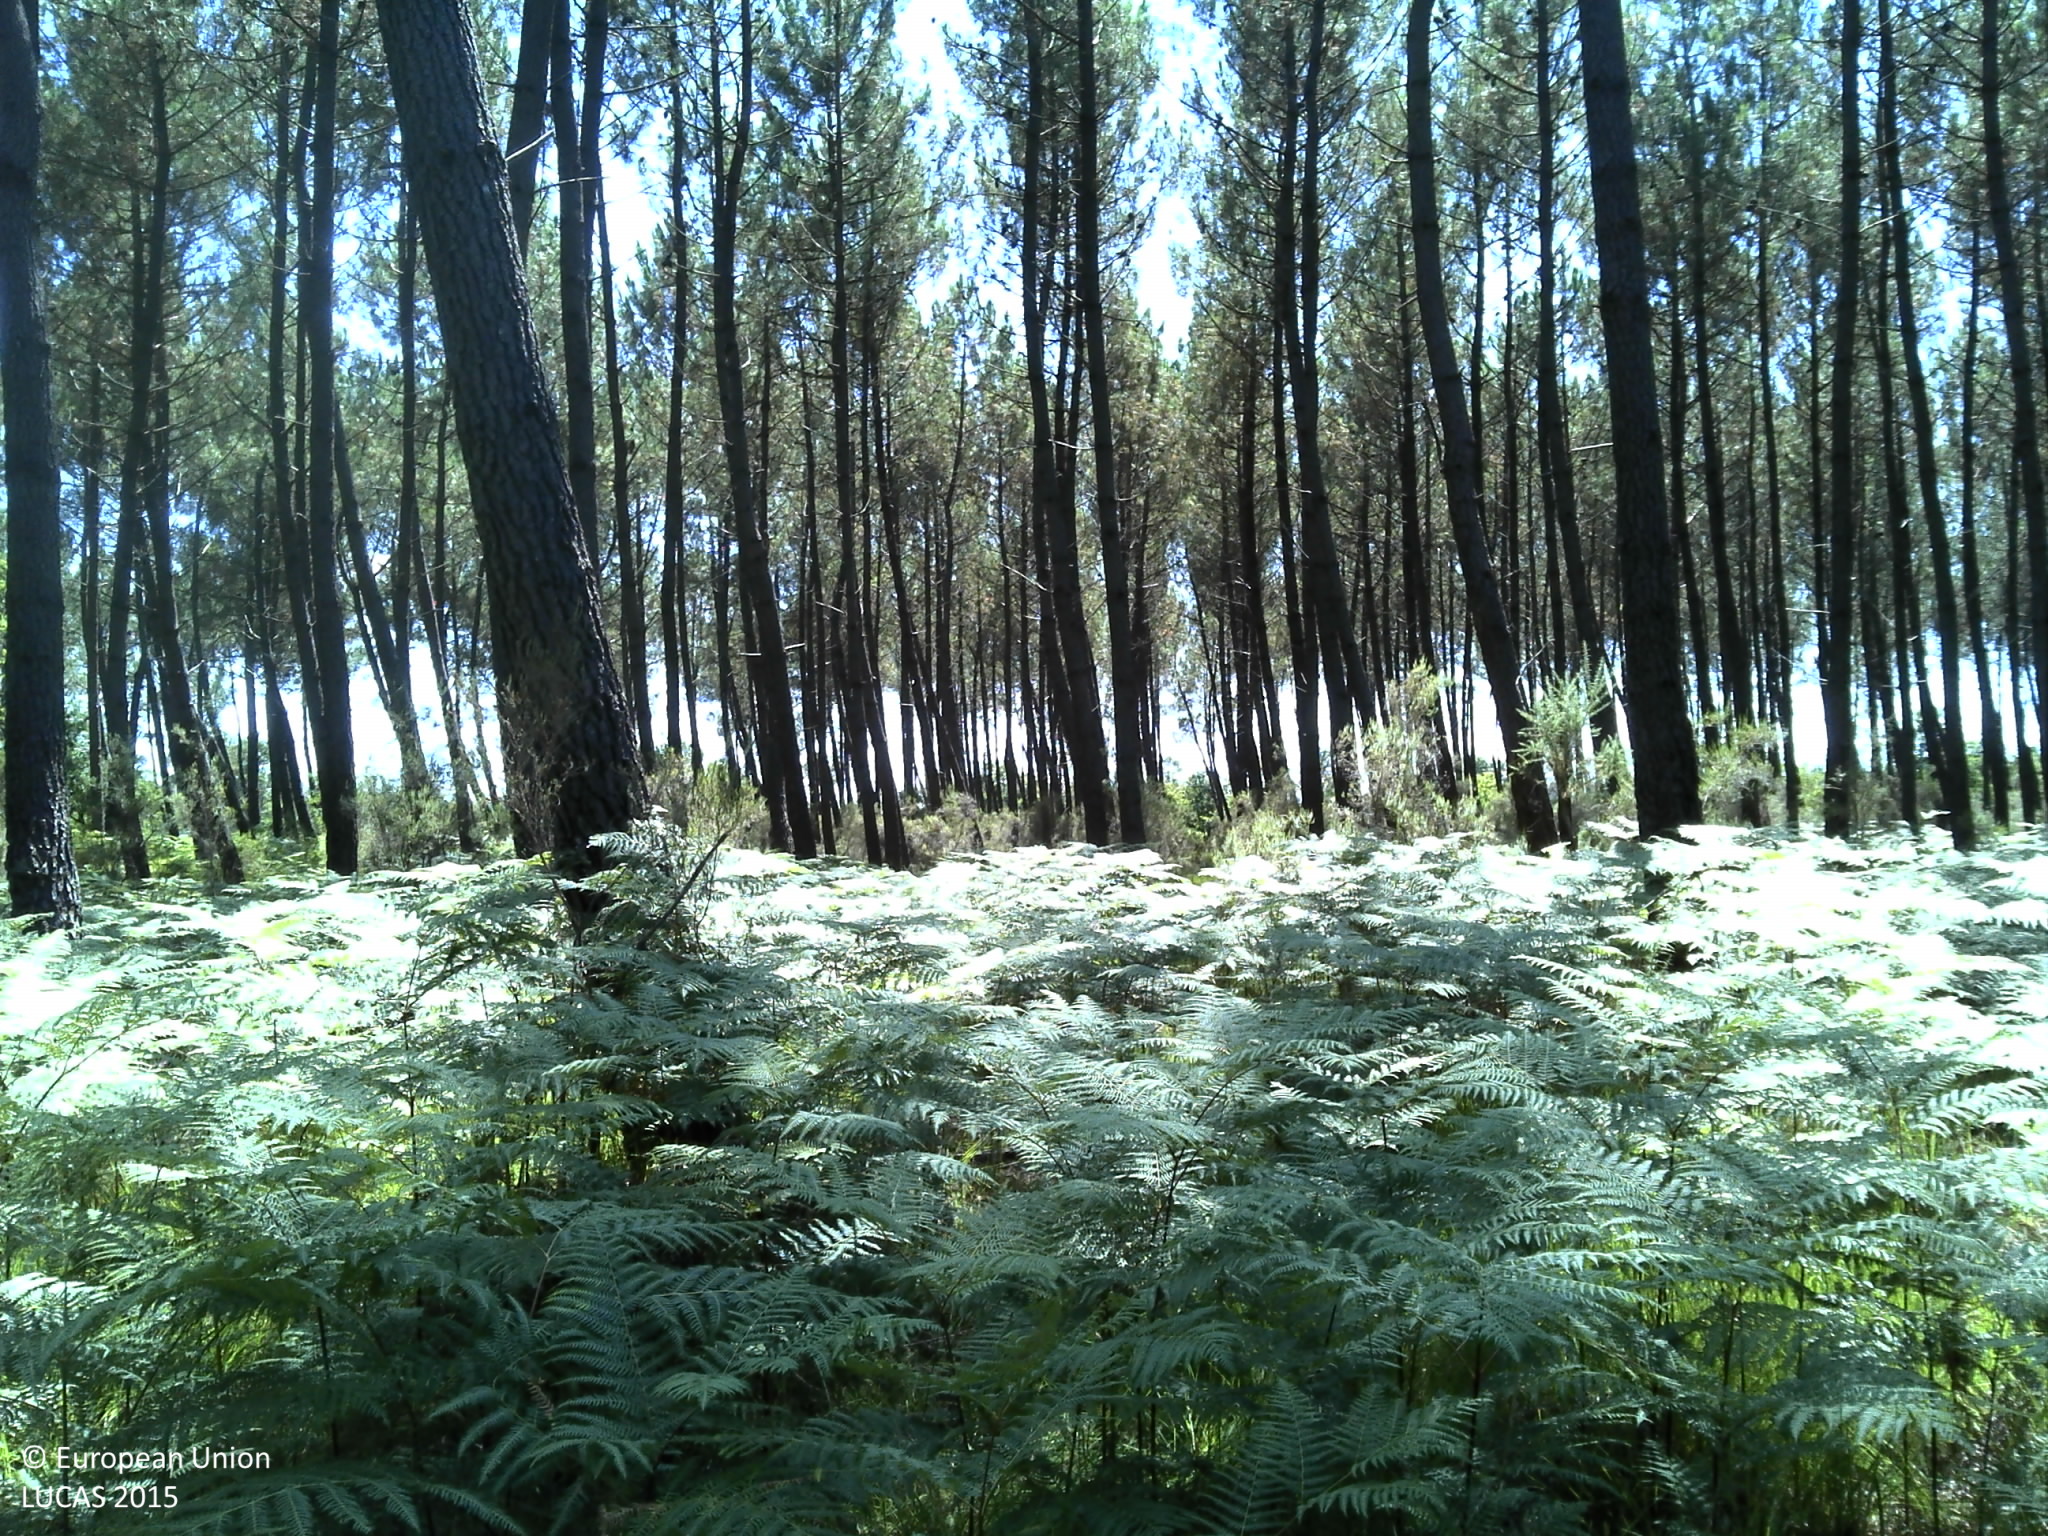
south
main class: Woodland
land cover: Pine dominated coniferous woodland
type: coniferous forest of the mediterranean region
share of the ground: > 75 %
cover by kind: shrubs 45 %, coniferous forest trees 40 %, herbaceous plants 10 %, broadleaved forest trees 5 %
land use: Forestry
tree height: > 5 m
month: August
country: FR
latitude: 45.1788
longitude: -1.0327
